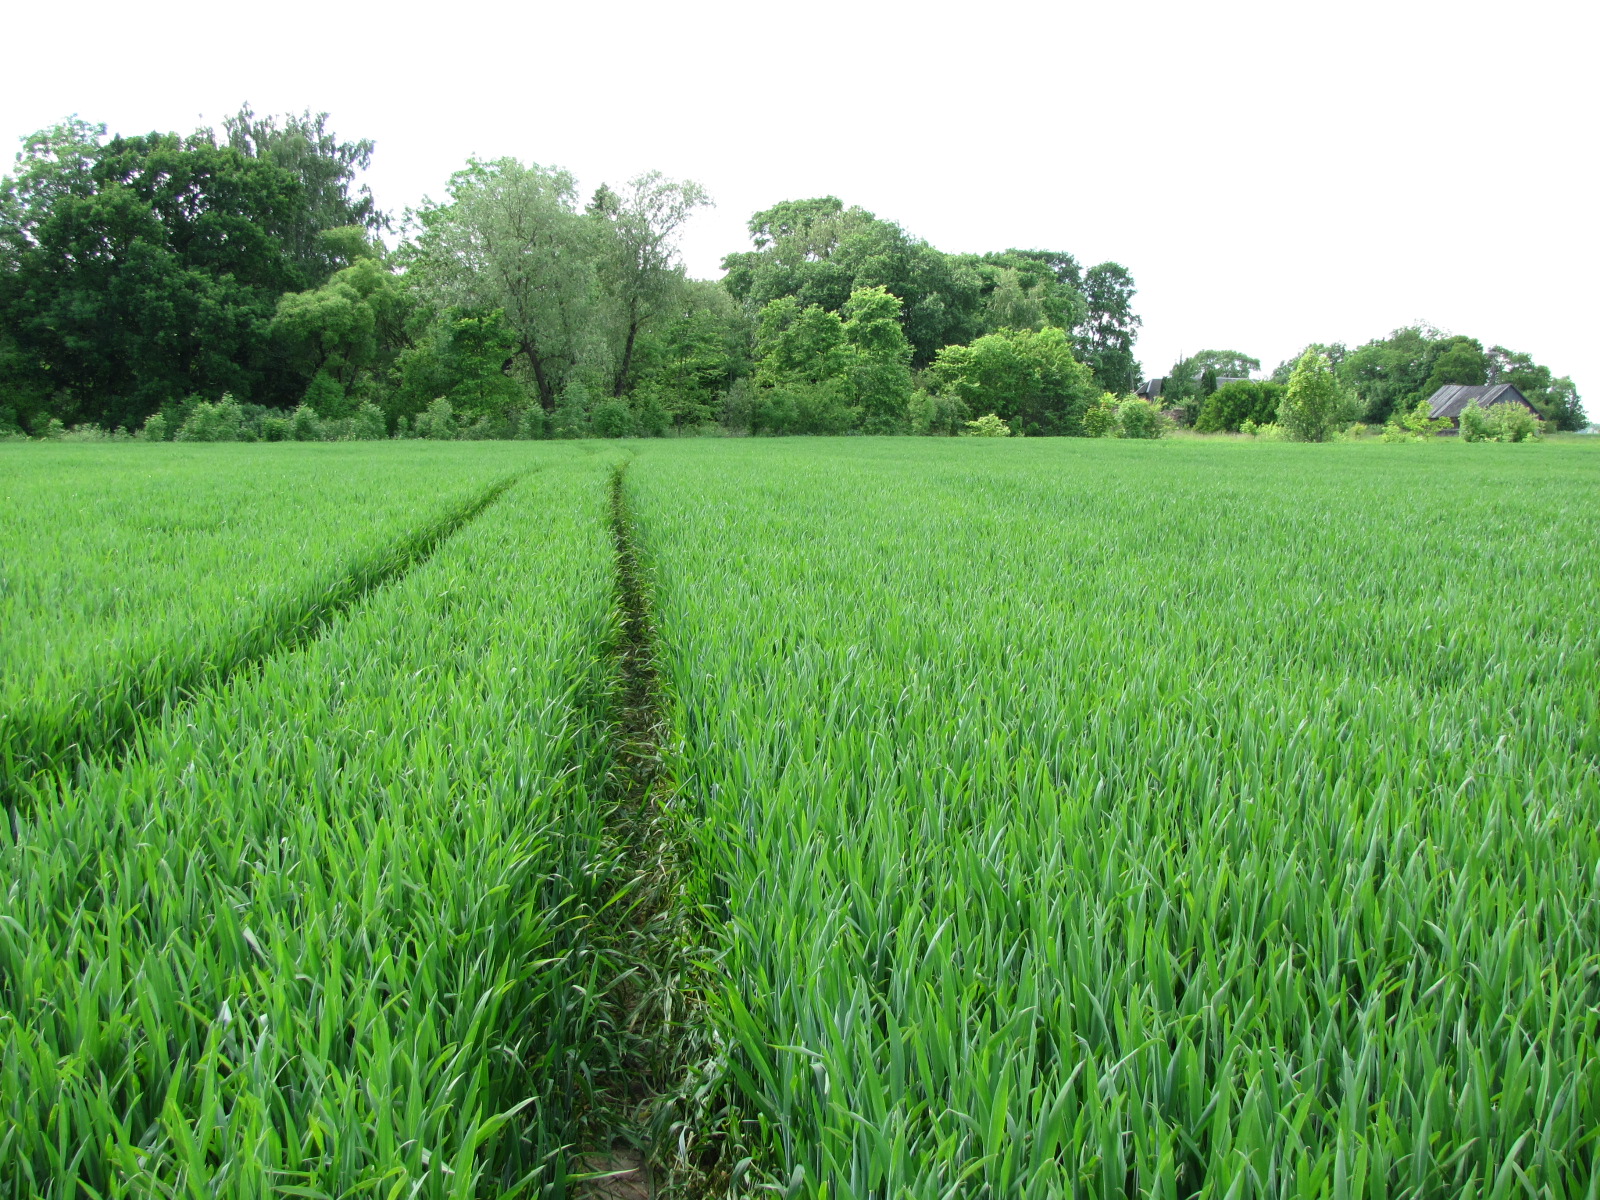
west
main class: Cropland
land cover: Common wheat
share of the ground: > 75 %
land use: Agriculture (excluding fallow land and kitchen gardens)
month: June
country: LV
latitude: 56.2858
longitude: 24.2259
